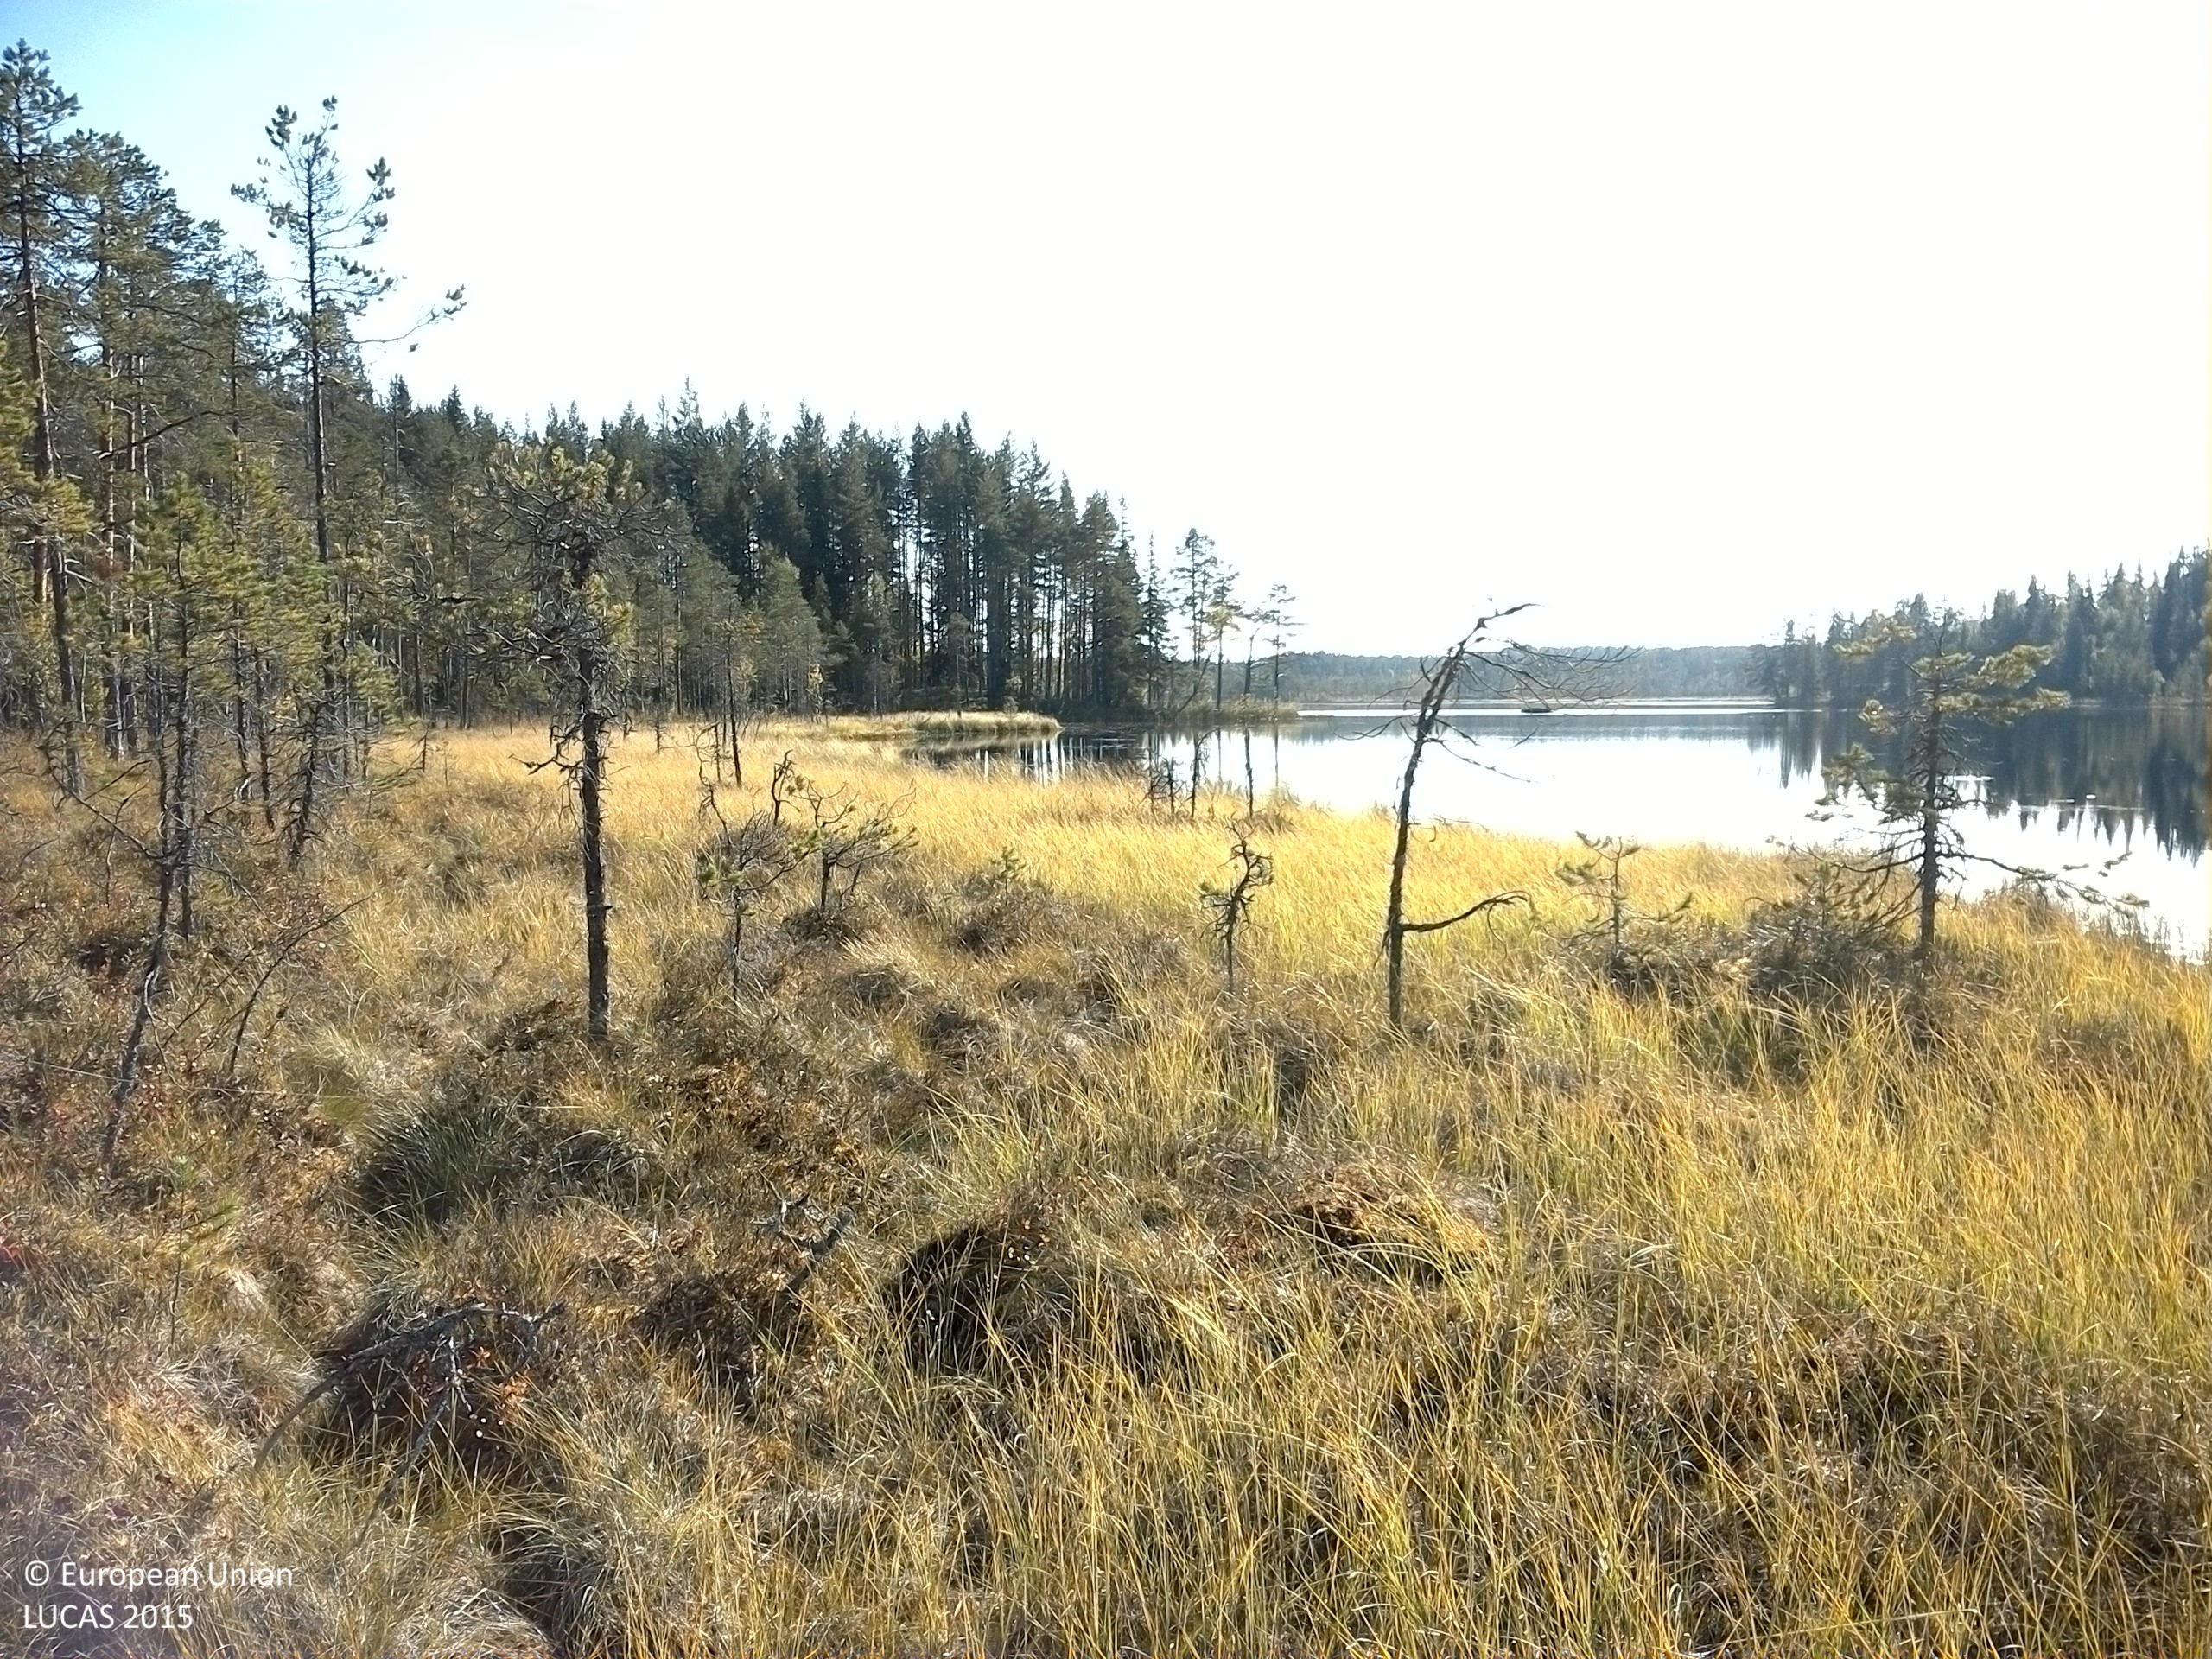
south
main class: Woodland
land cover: Pine dominated coniferous woodland
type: mire and swamp forests
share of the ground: 10 - 25 %
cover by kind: shrubs 35 %, herbaceous plants 35 %, coniferous forest trees 15 %, lichens and mosses 15 %
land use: Semi-natural and natural areas not in use
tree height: < 5 m
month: September
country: SE
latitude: 63.9592
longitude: 16.4431
